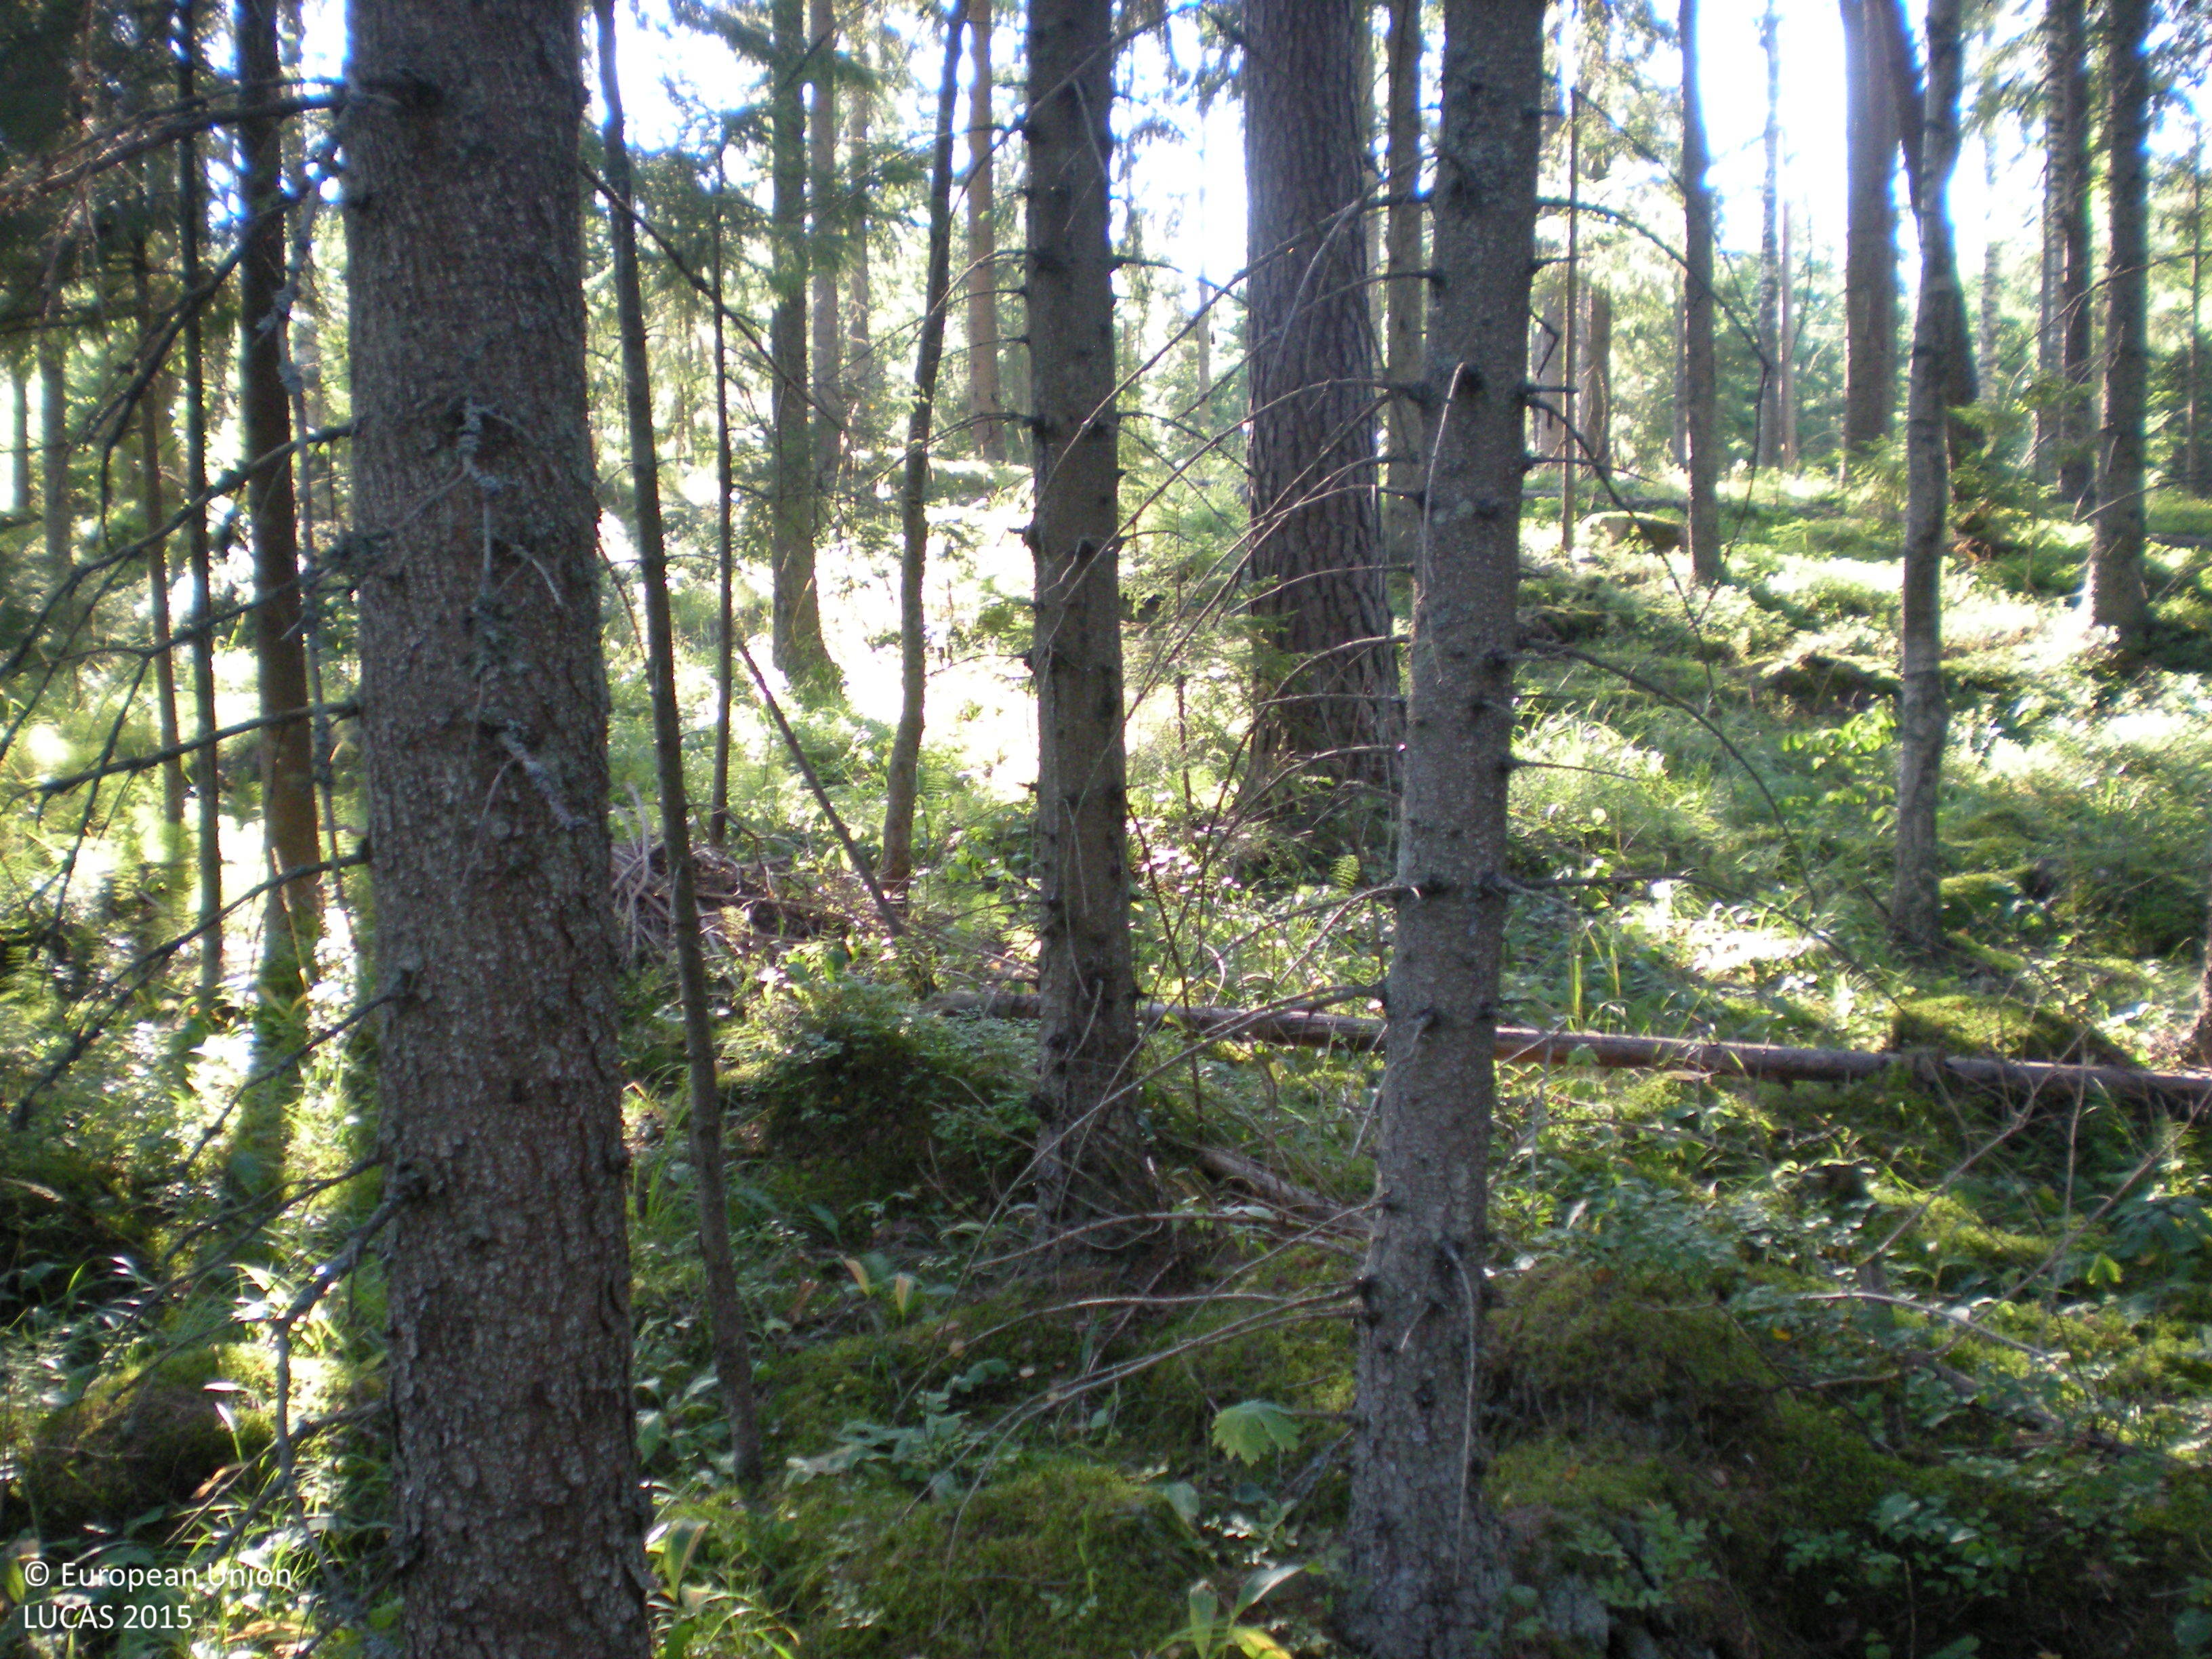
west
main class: Woodland
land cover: Spruce dominated coniferous woodland
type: boreal forest
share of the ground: 50 - 75 %
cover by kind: coniferous forest trees 70 %, herbaceous plants 10 %, lichens and mosses 10 %, broadleaved forest trees 5 %, shrubs 5 %
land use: Forestry
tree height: > 5 m
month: August
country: SE
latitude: 60.5701
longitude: 17.3062
